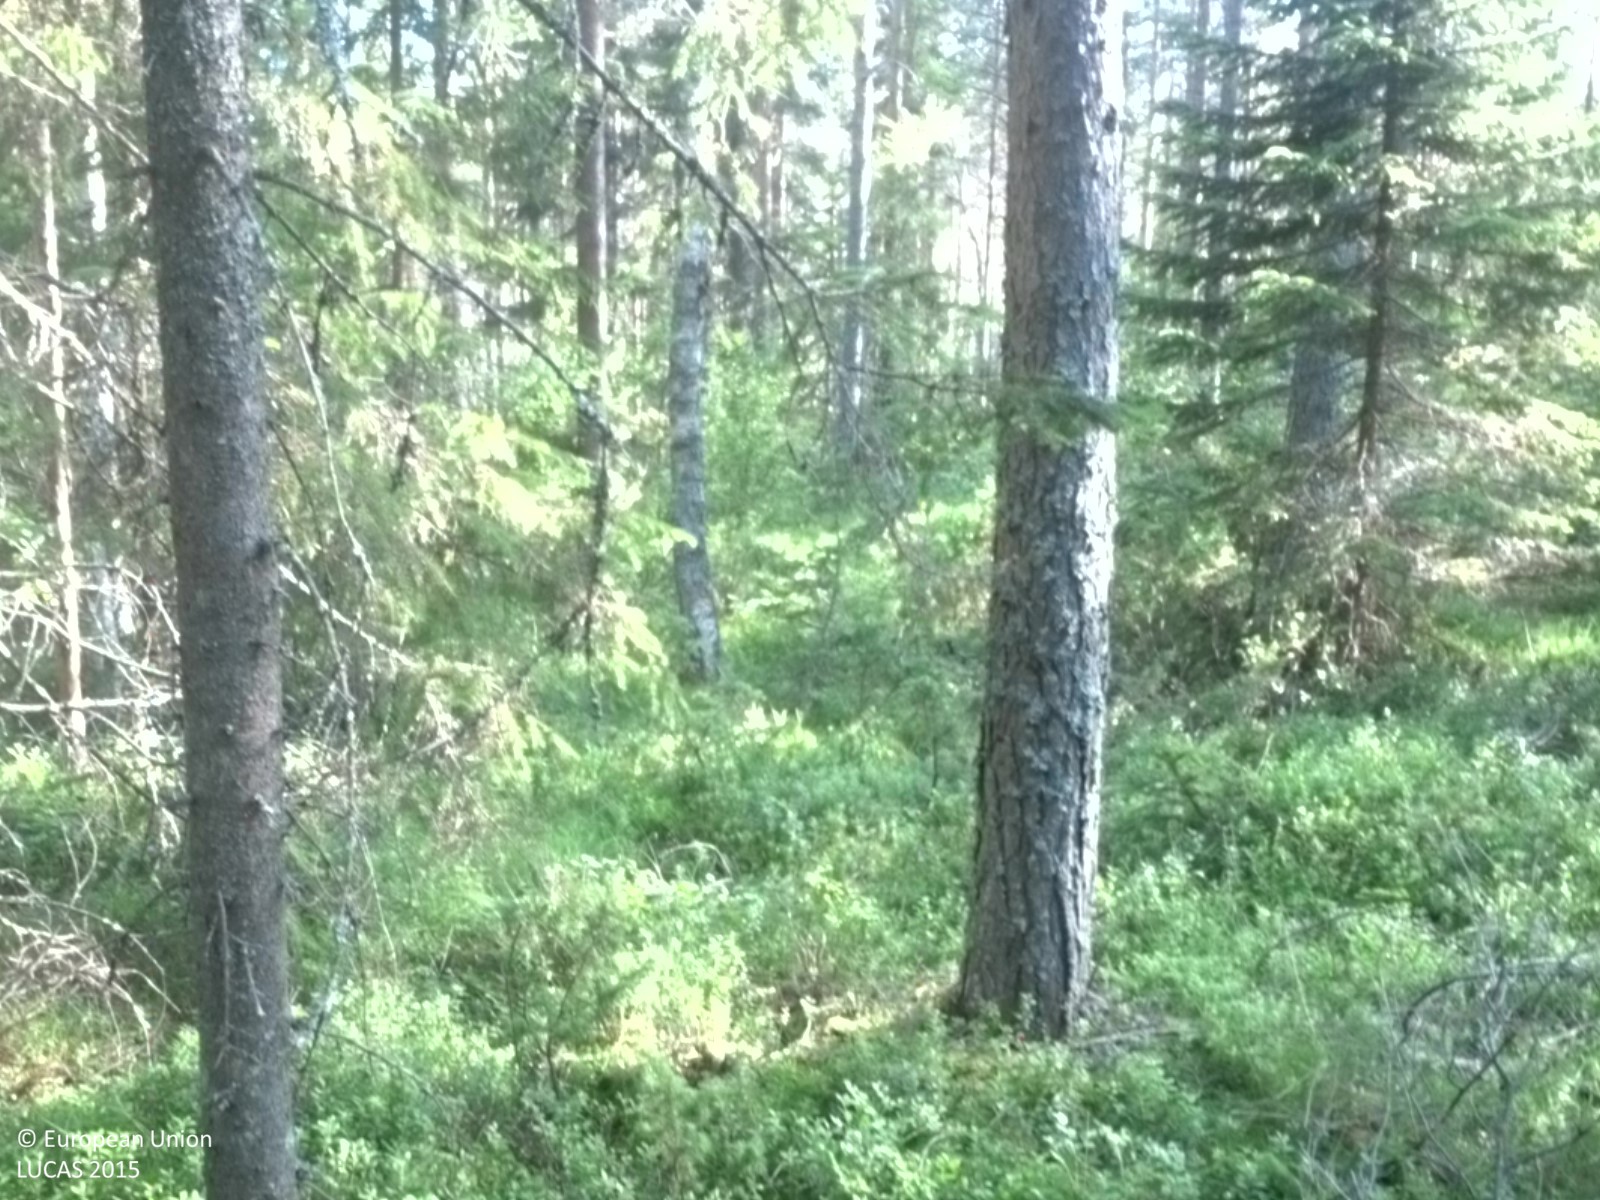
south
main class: Woodland
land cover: Other mixed woodland
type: boreal forest
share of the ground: 50 - 75 %
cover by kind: coniferous forest trees 40 %, herbaceous plants 30 %, broadleaved forest trees 20 %, shrubs 10 %
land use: Forestry
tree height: > 5 m
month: July
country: SE
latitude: 63.6868
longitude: 19.9088
